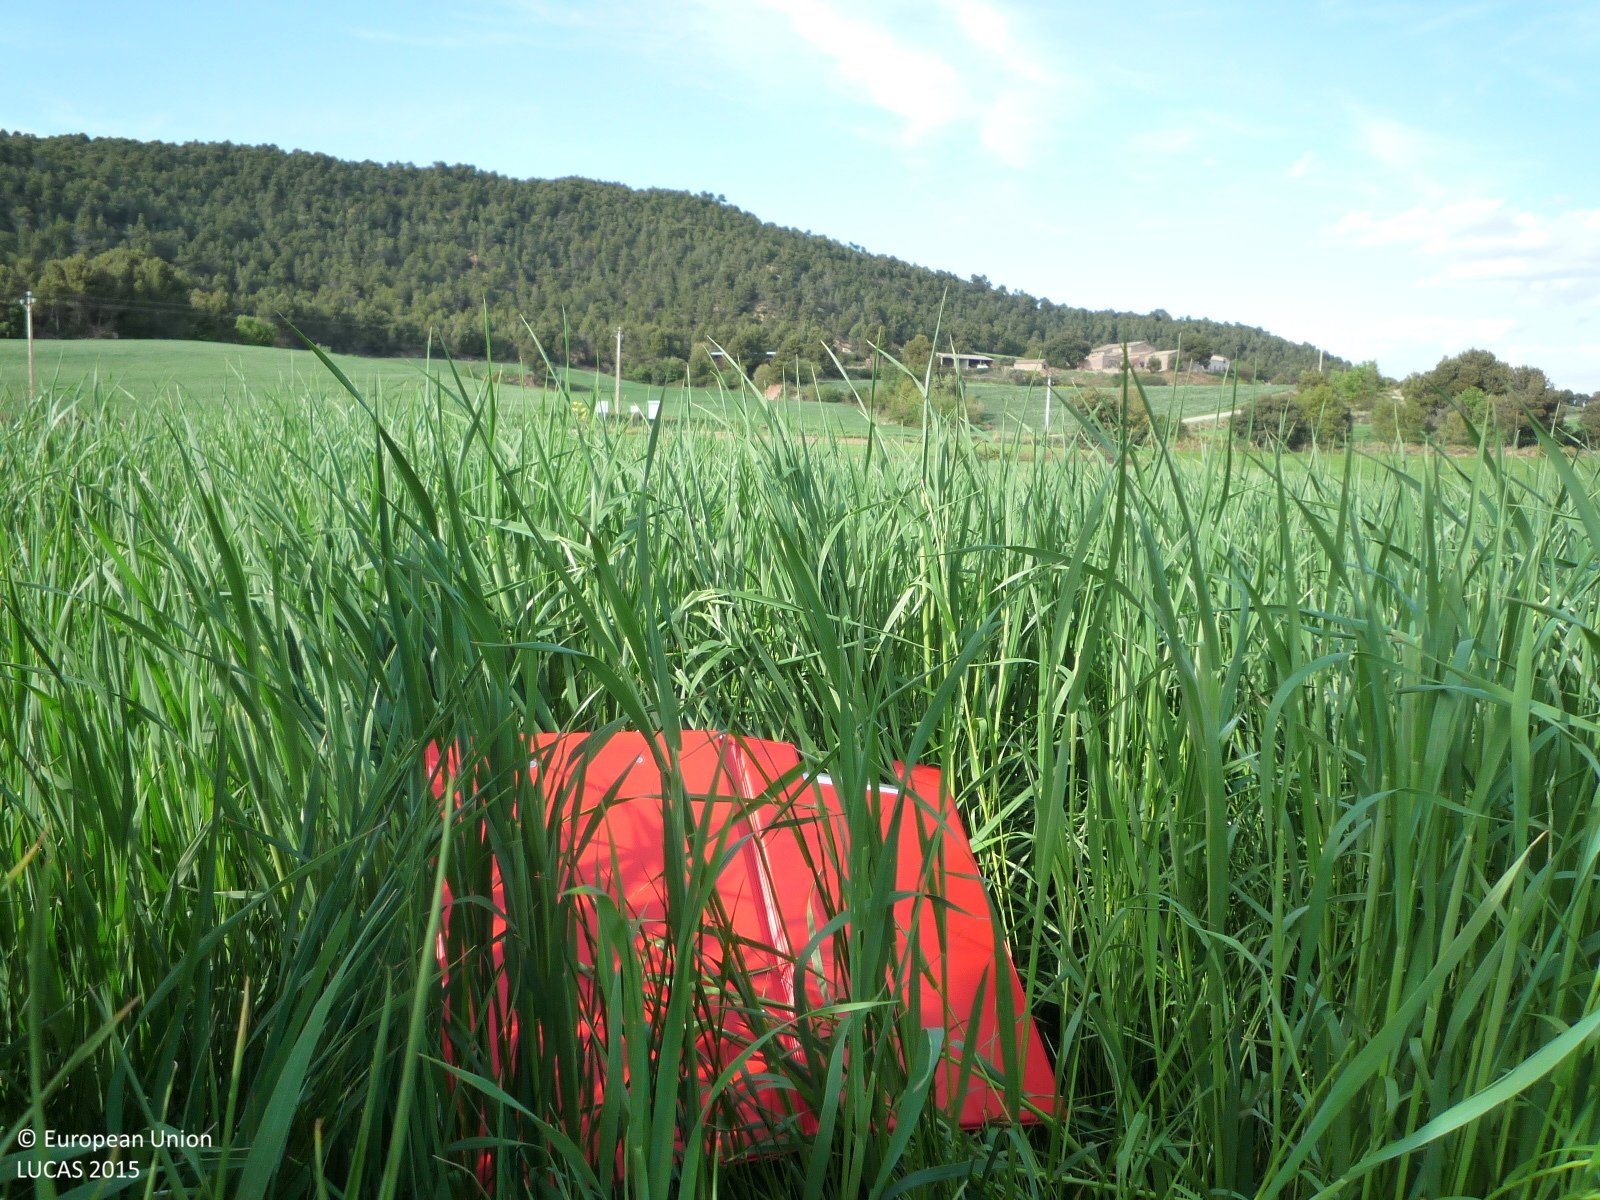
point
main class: Cropland
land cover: Oats
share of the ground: > 75 %
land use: Agriculture (excluding fallow land and kitchen gardens)
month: April
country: ES
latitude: 41.7467
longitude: 1.6571
